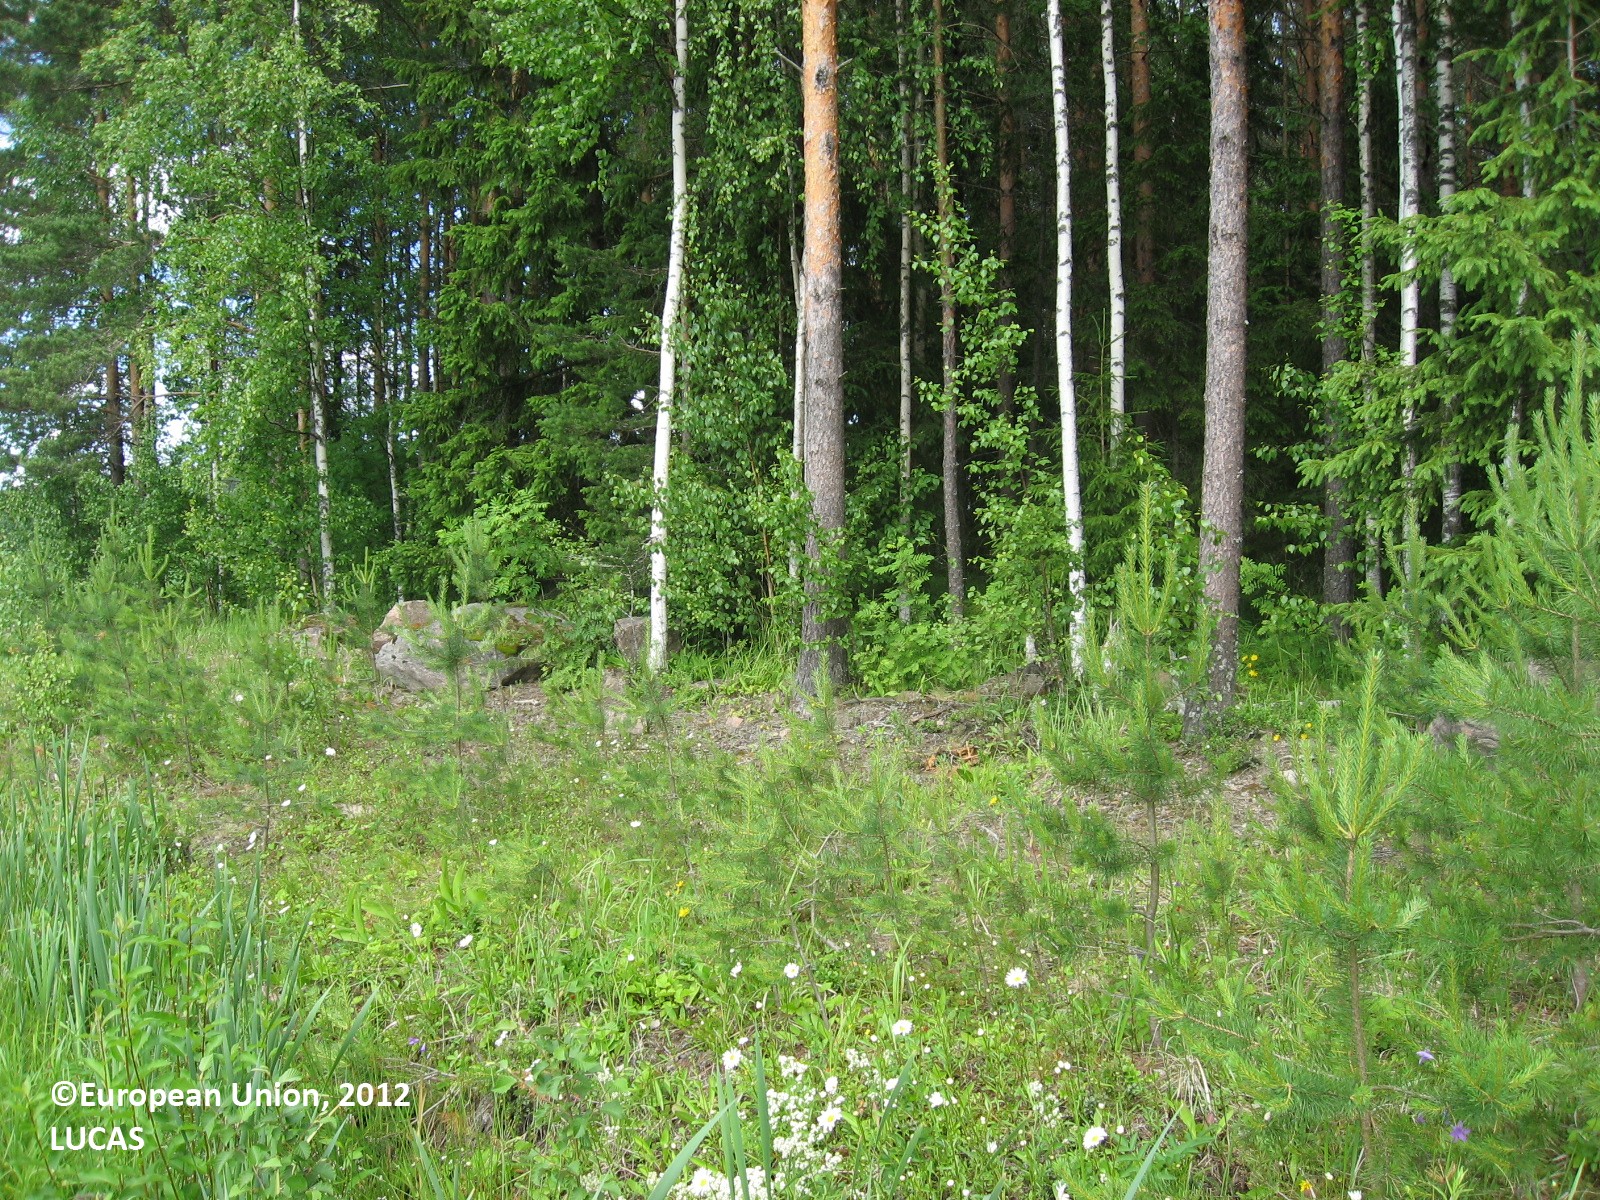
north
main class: Grassland
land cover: Spontaneously vegetated surfaces
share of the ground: < 10 %
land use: Fallow land
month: June
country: FI
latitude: 60.7964
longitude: 26.4116
